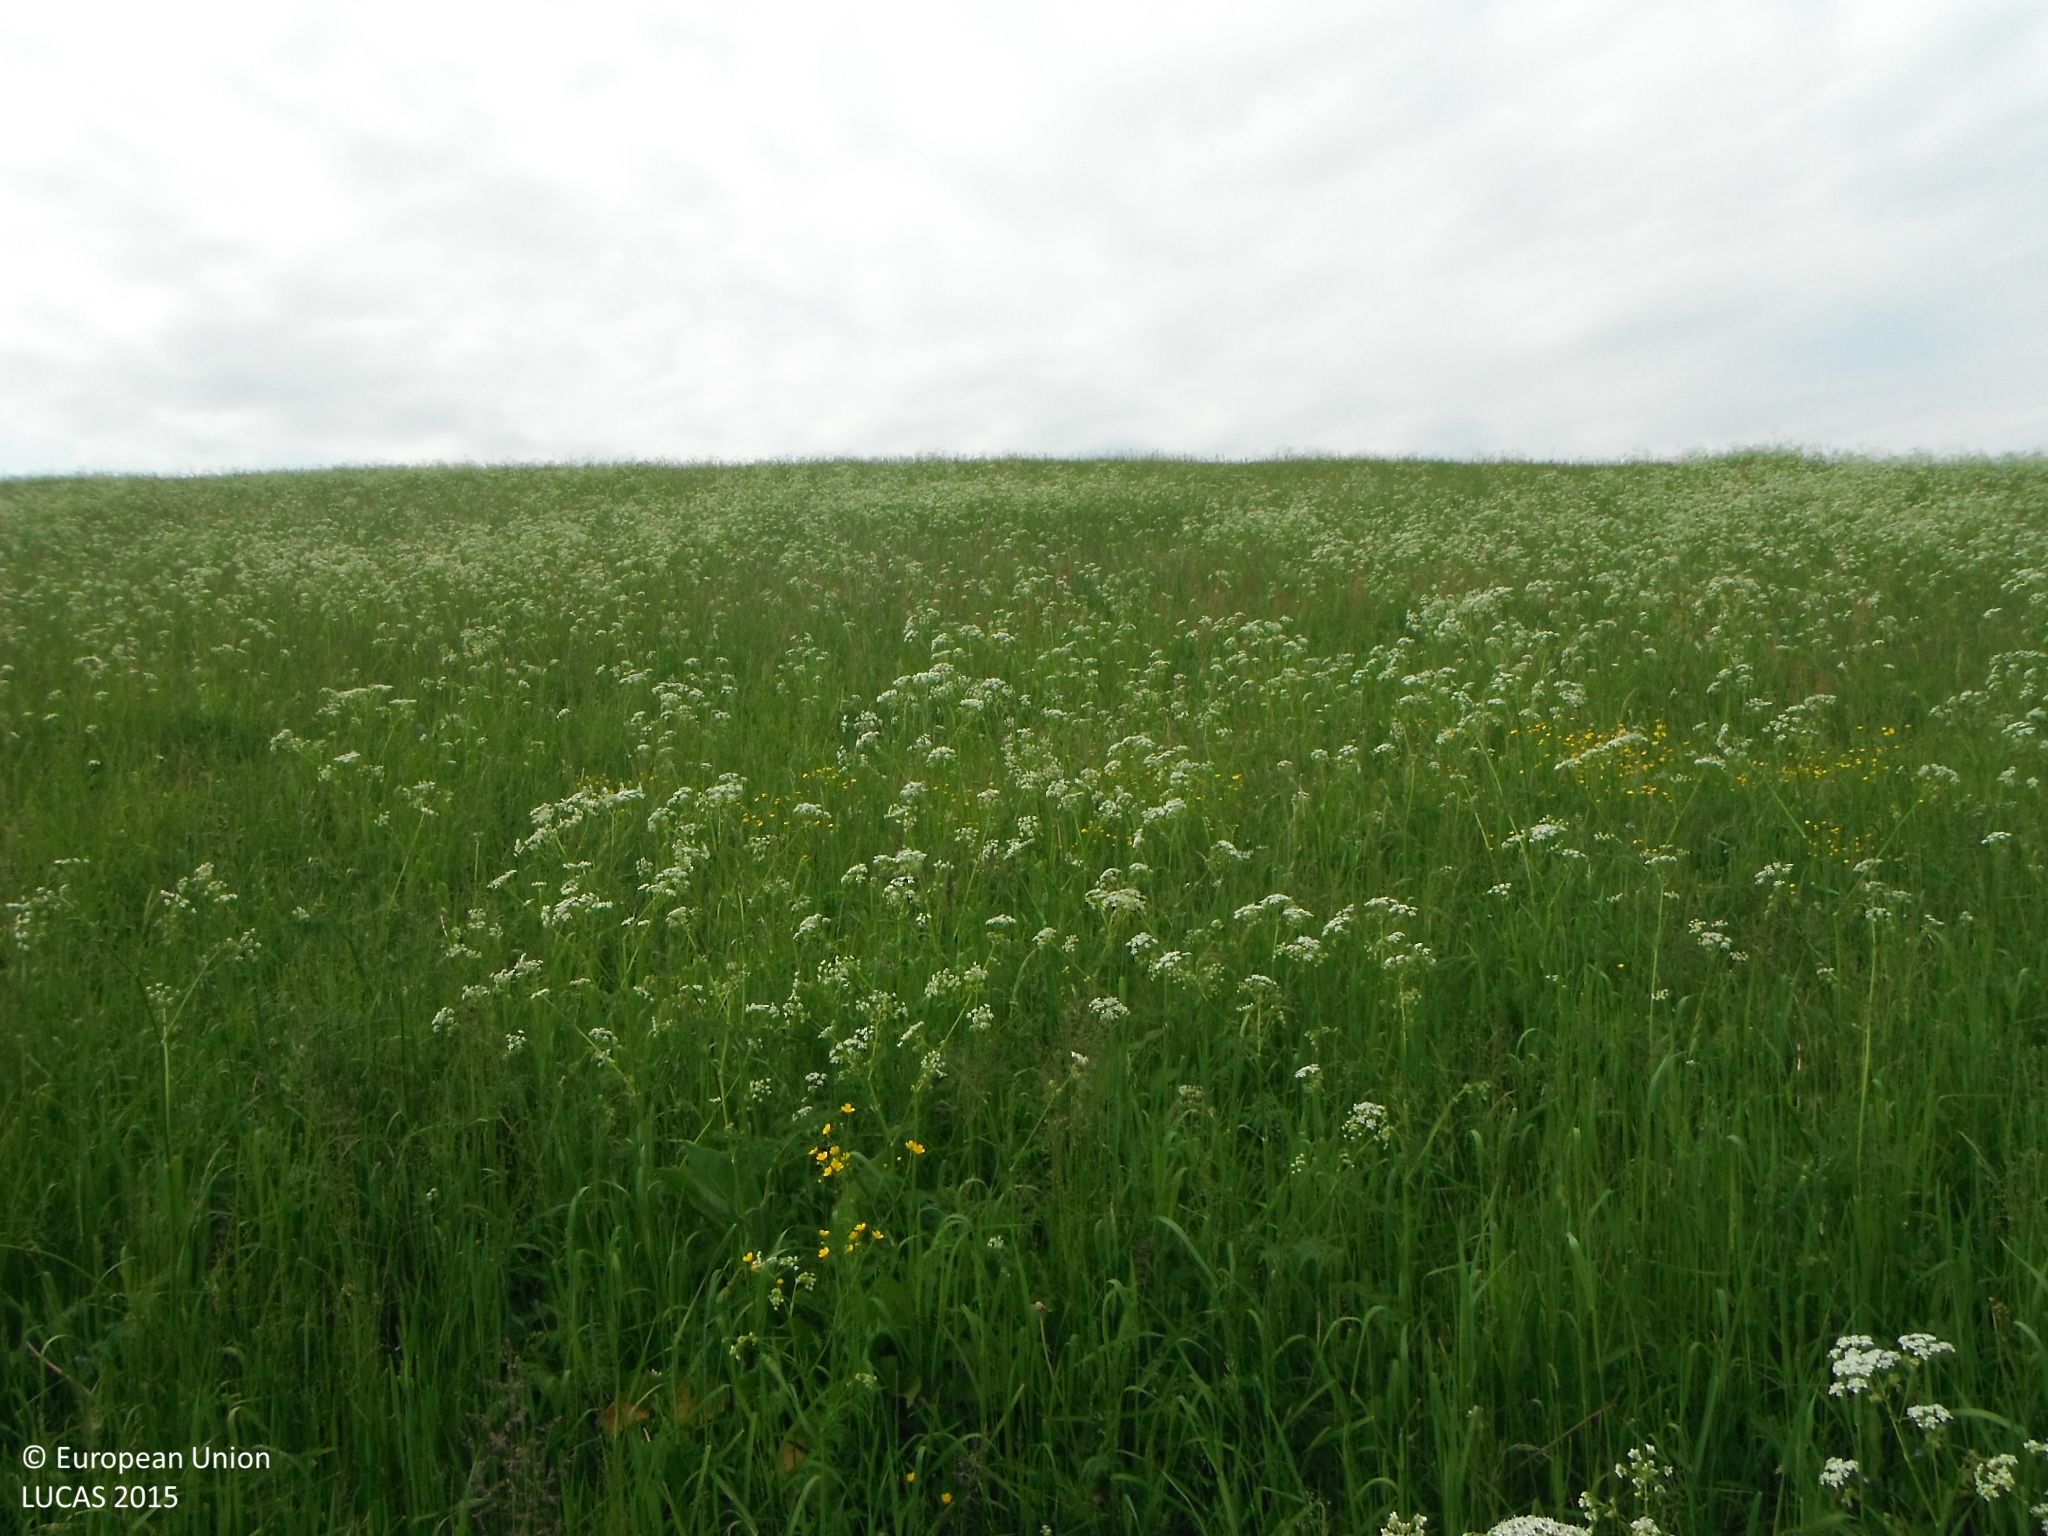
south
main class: Grassland
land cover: Grassland without tree/shrub cover
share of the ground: > 75 %
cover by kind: herbaceous plants 100 %
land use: Agriculture (excluding fallow land and kitchen gardens)
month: June
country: SK
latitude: 49.3827
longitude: 20.3804
